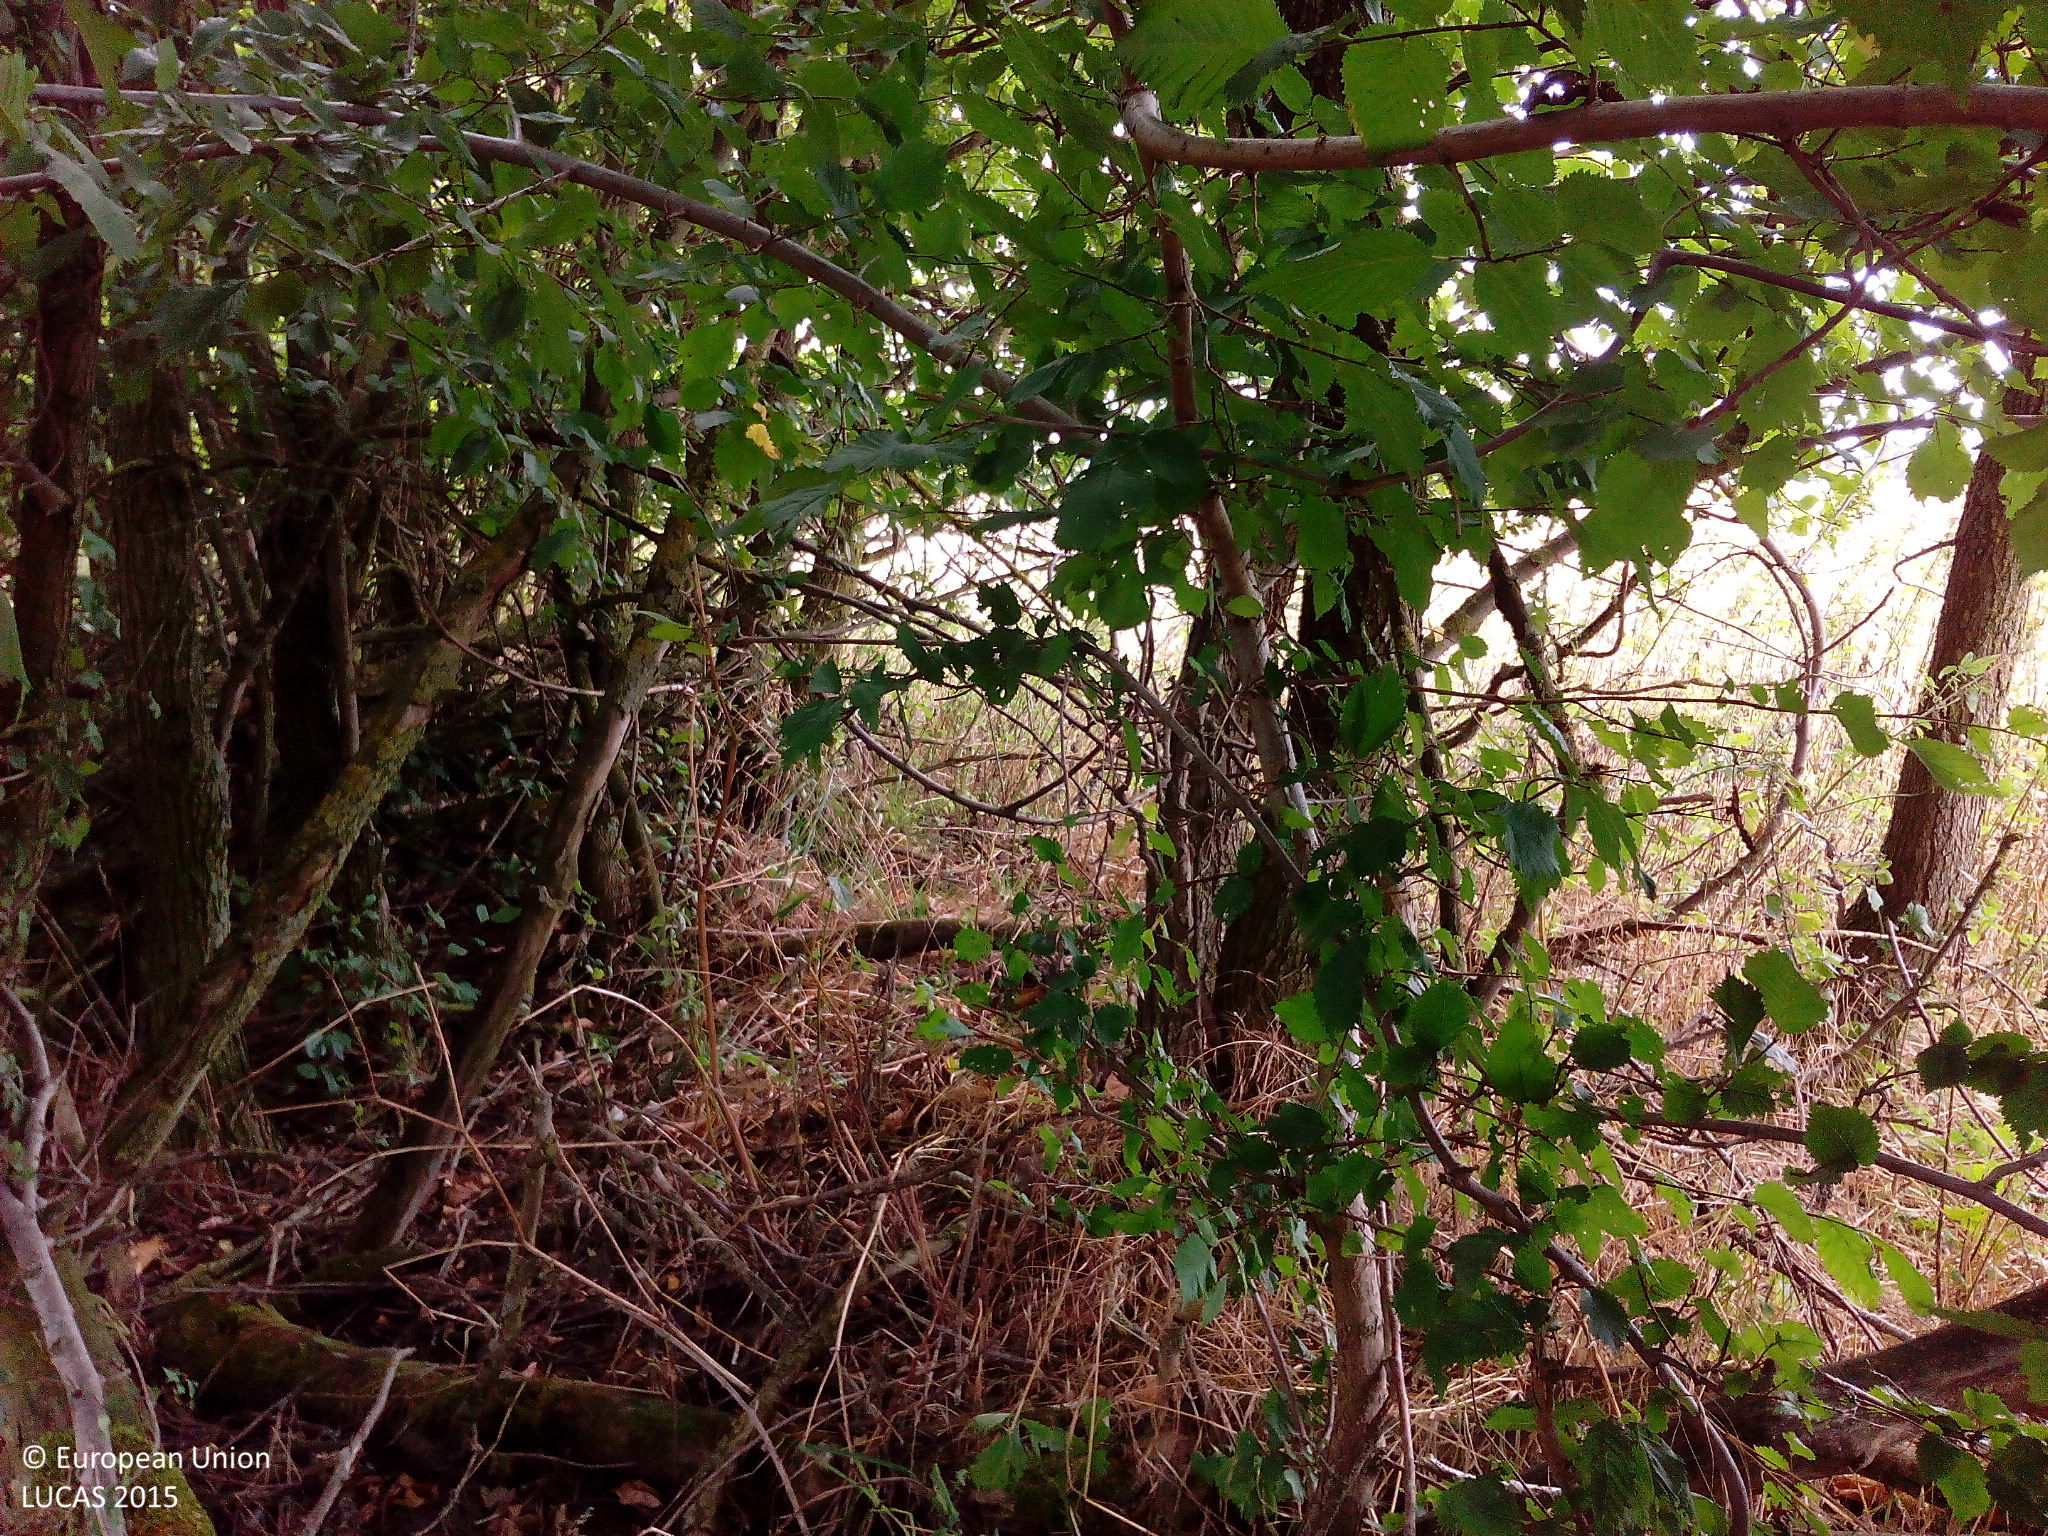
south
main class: Woodland
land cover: Broadleaved woodland
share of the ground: 50 - 75 %
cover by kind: herbaceous plants 80 %, broadleaved forest trees 10 %, unconsolidated bare surface 10 %
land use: Semi-natural and natural areas not in use
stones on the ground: < 10 %
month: August
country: DE
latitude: 53.9135
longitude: 12.6025
